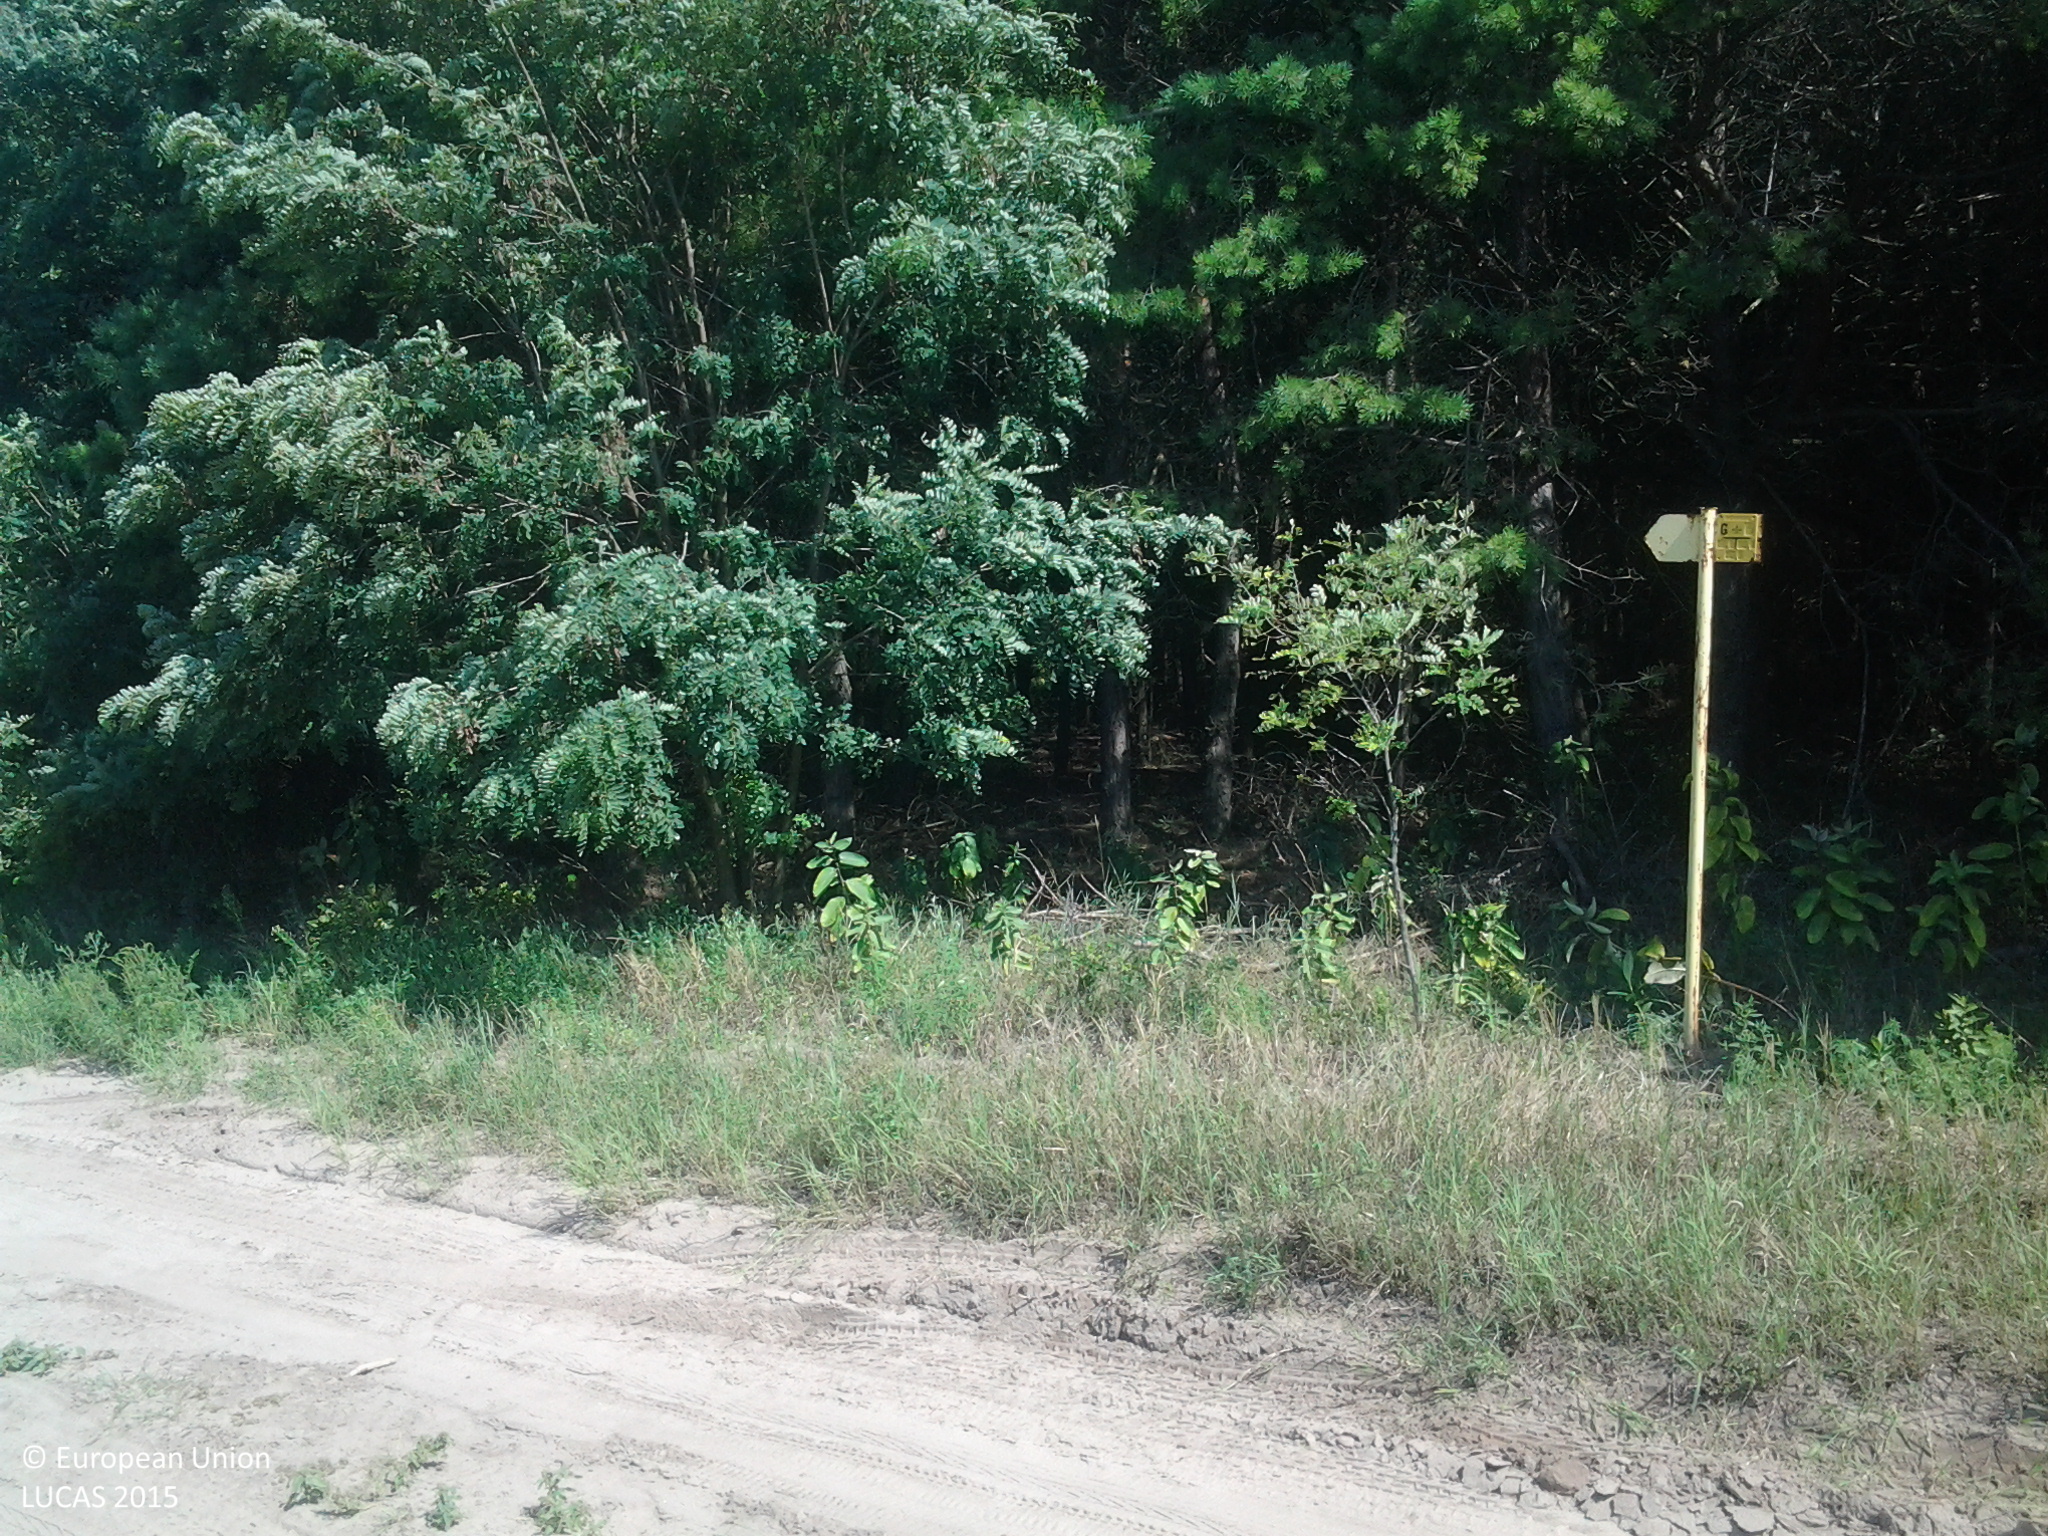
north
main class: Woodland
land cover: Pine dominated coniferous woodland
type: hemiboreal forest and nemoral coniferous forest and mixed broadleaved-coniferous forest
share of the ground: > 75 %
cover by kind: coniferous forest trees 100 %
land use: Forestry
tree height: > 5 m
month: August
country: HU
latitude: 46.7310
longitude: 19.6375
